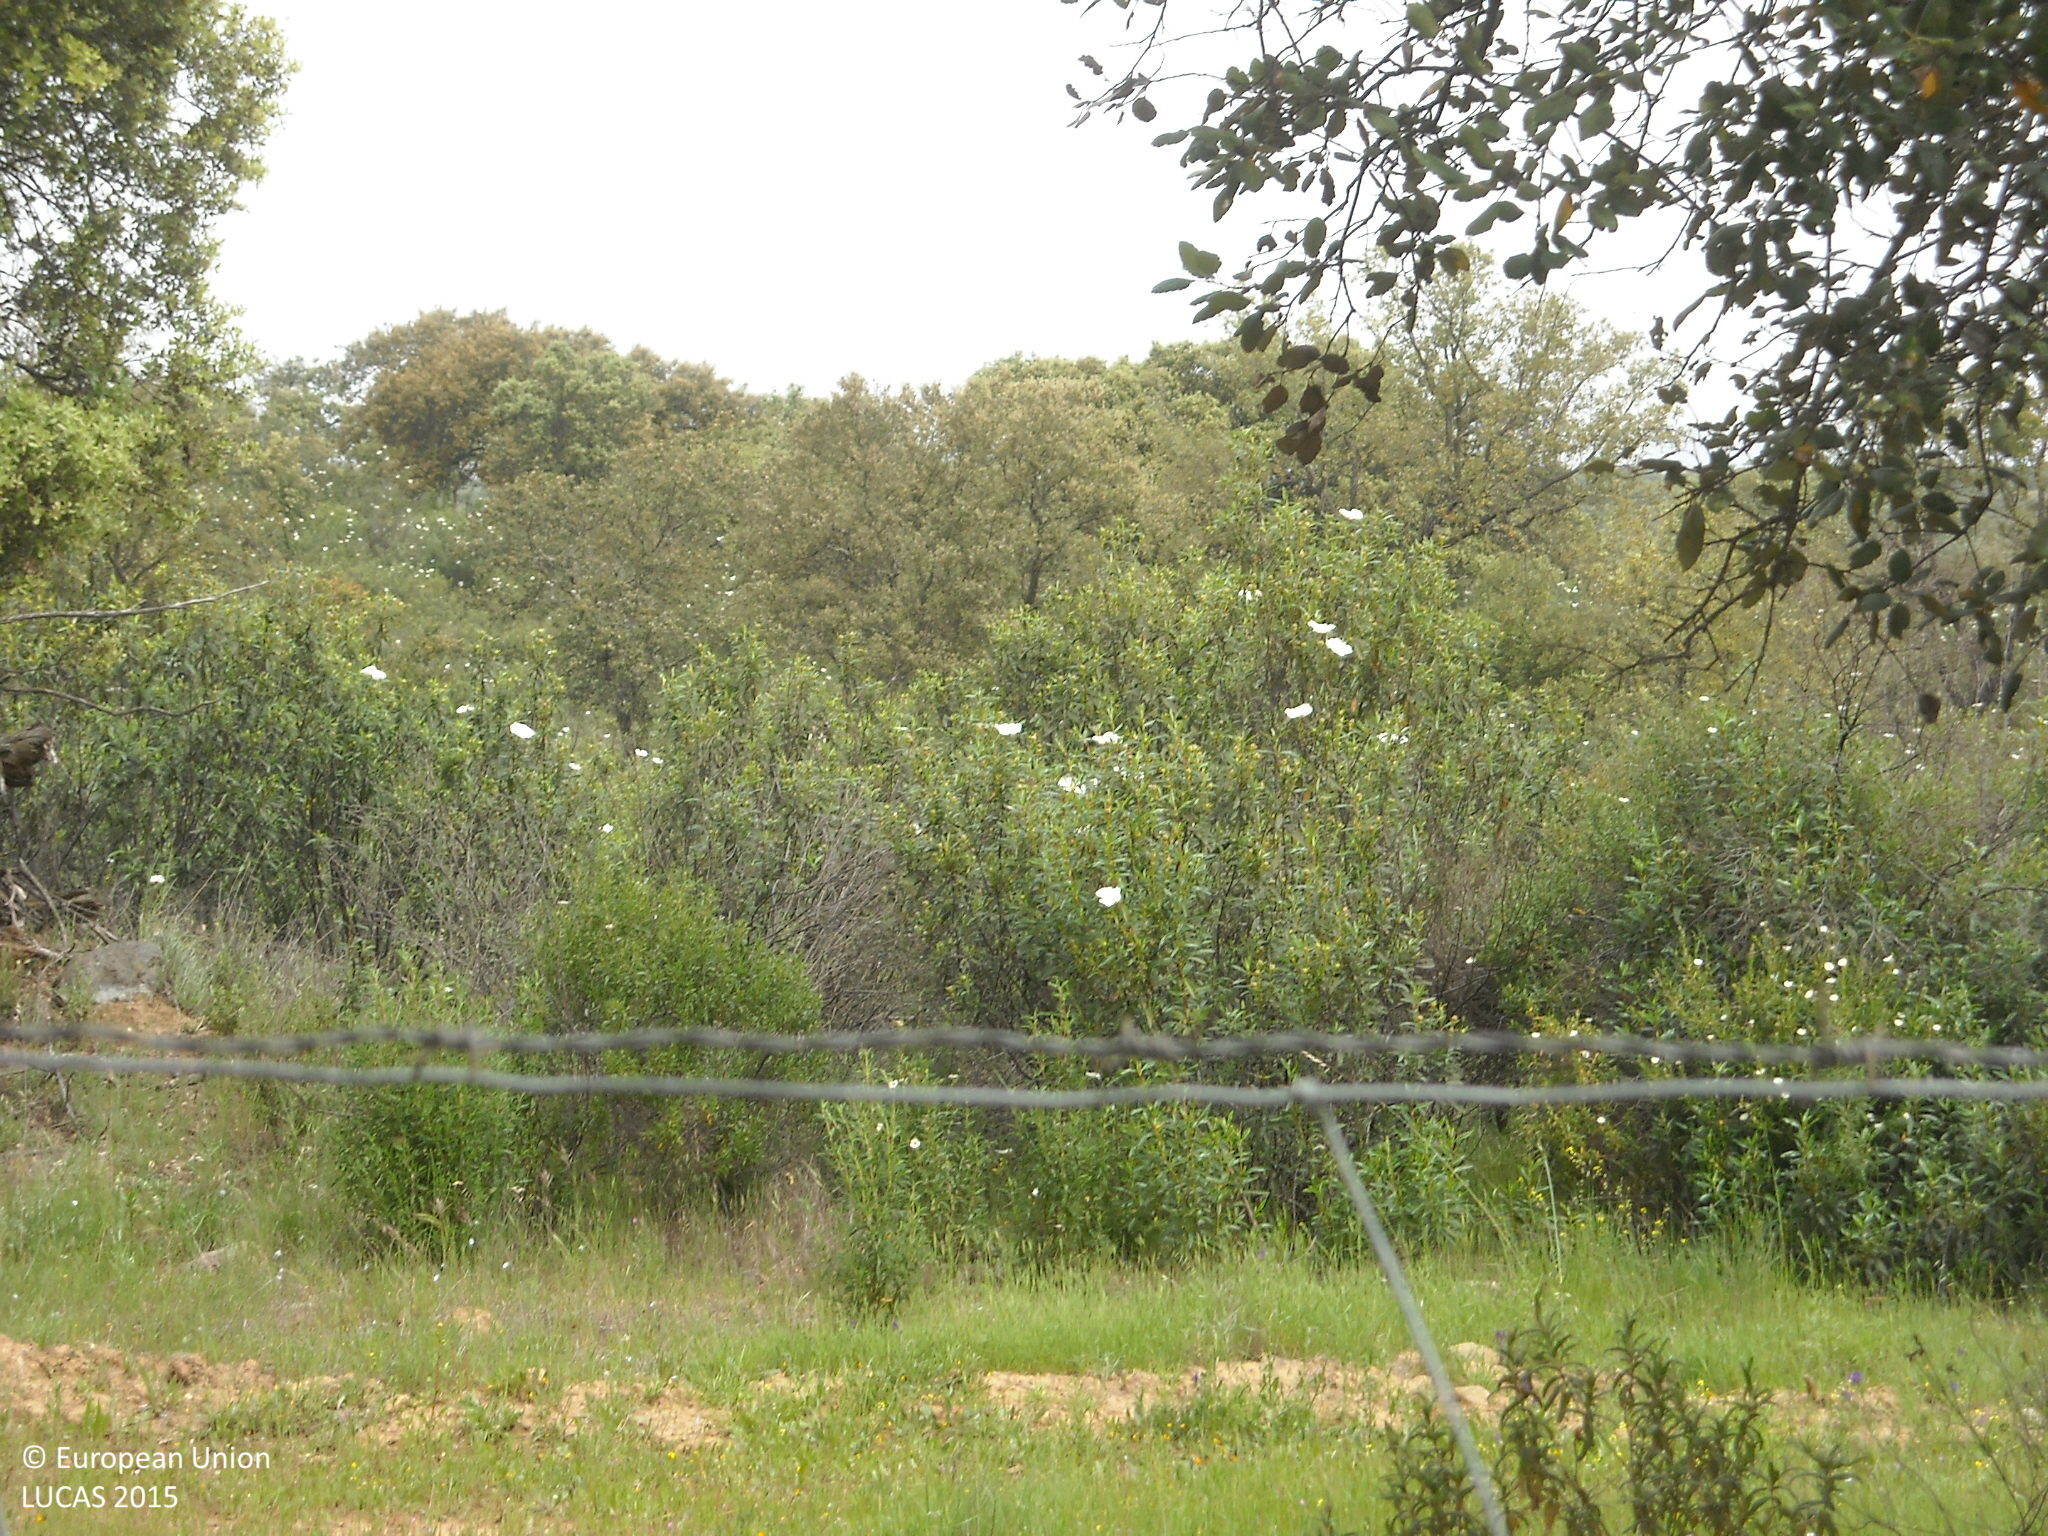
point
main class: Shrubland
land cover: Shrubland with sparse tree cover
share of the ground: 10 - 25 %
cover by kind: herbaceous plants 80 %, shrubs 15 %, broadleaved forest trees 5 %
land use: Forestry
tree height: > 5 m
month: April
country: ES
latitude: 37.8236
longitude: -6.2018
